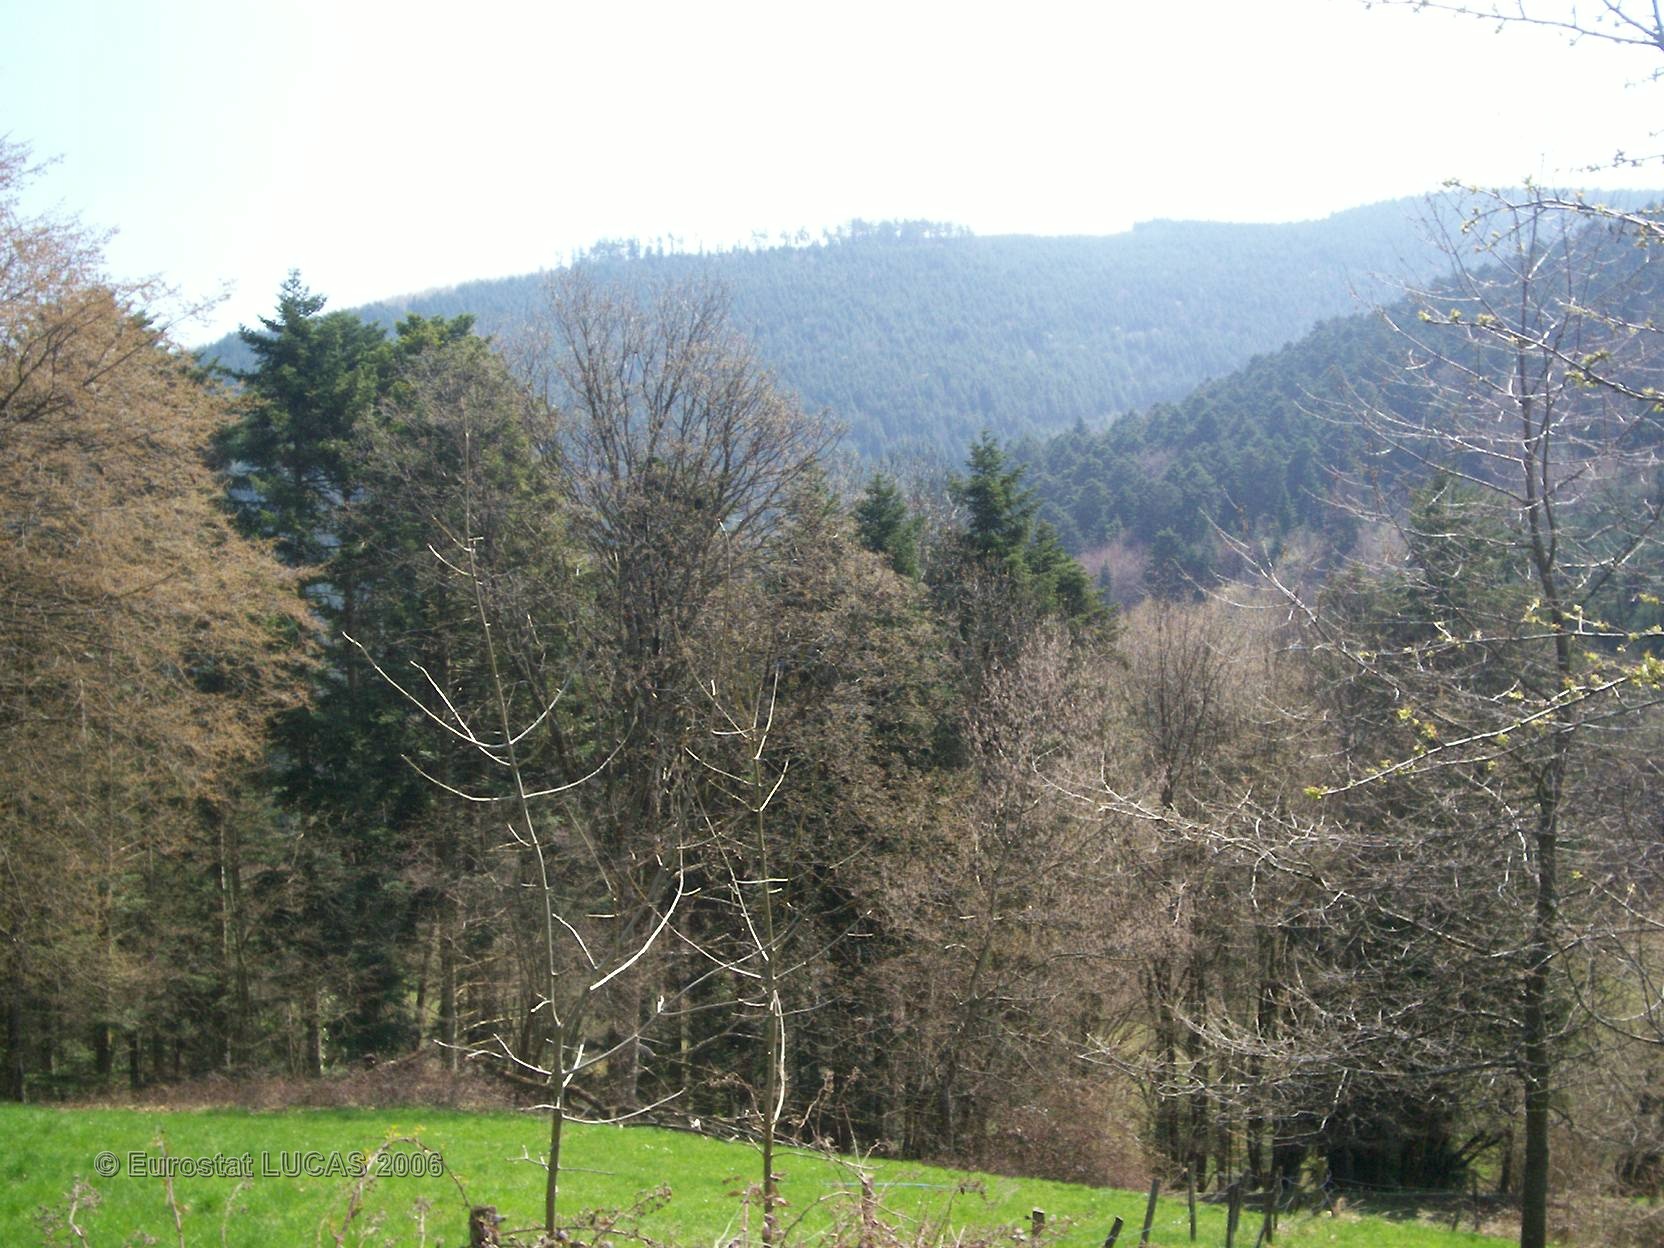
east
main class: Cropland
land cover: Other fruit trees and berries
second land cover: Grassland with sparse tree/shrub cover
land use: Kitchen garden
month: April
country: FR
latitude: 48.0238
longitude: 7.1183
